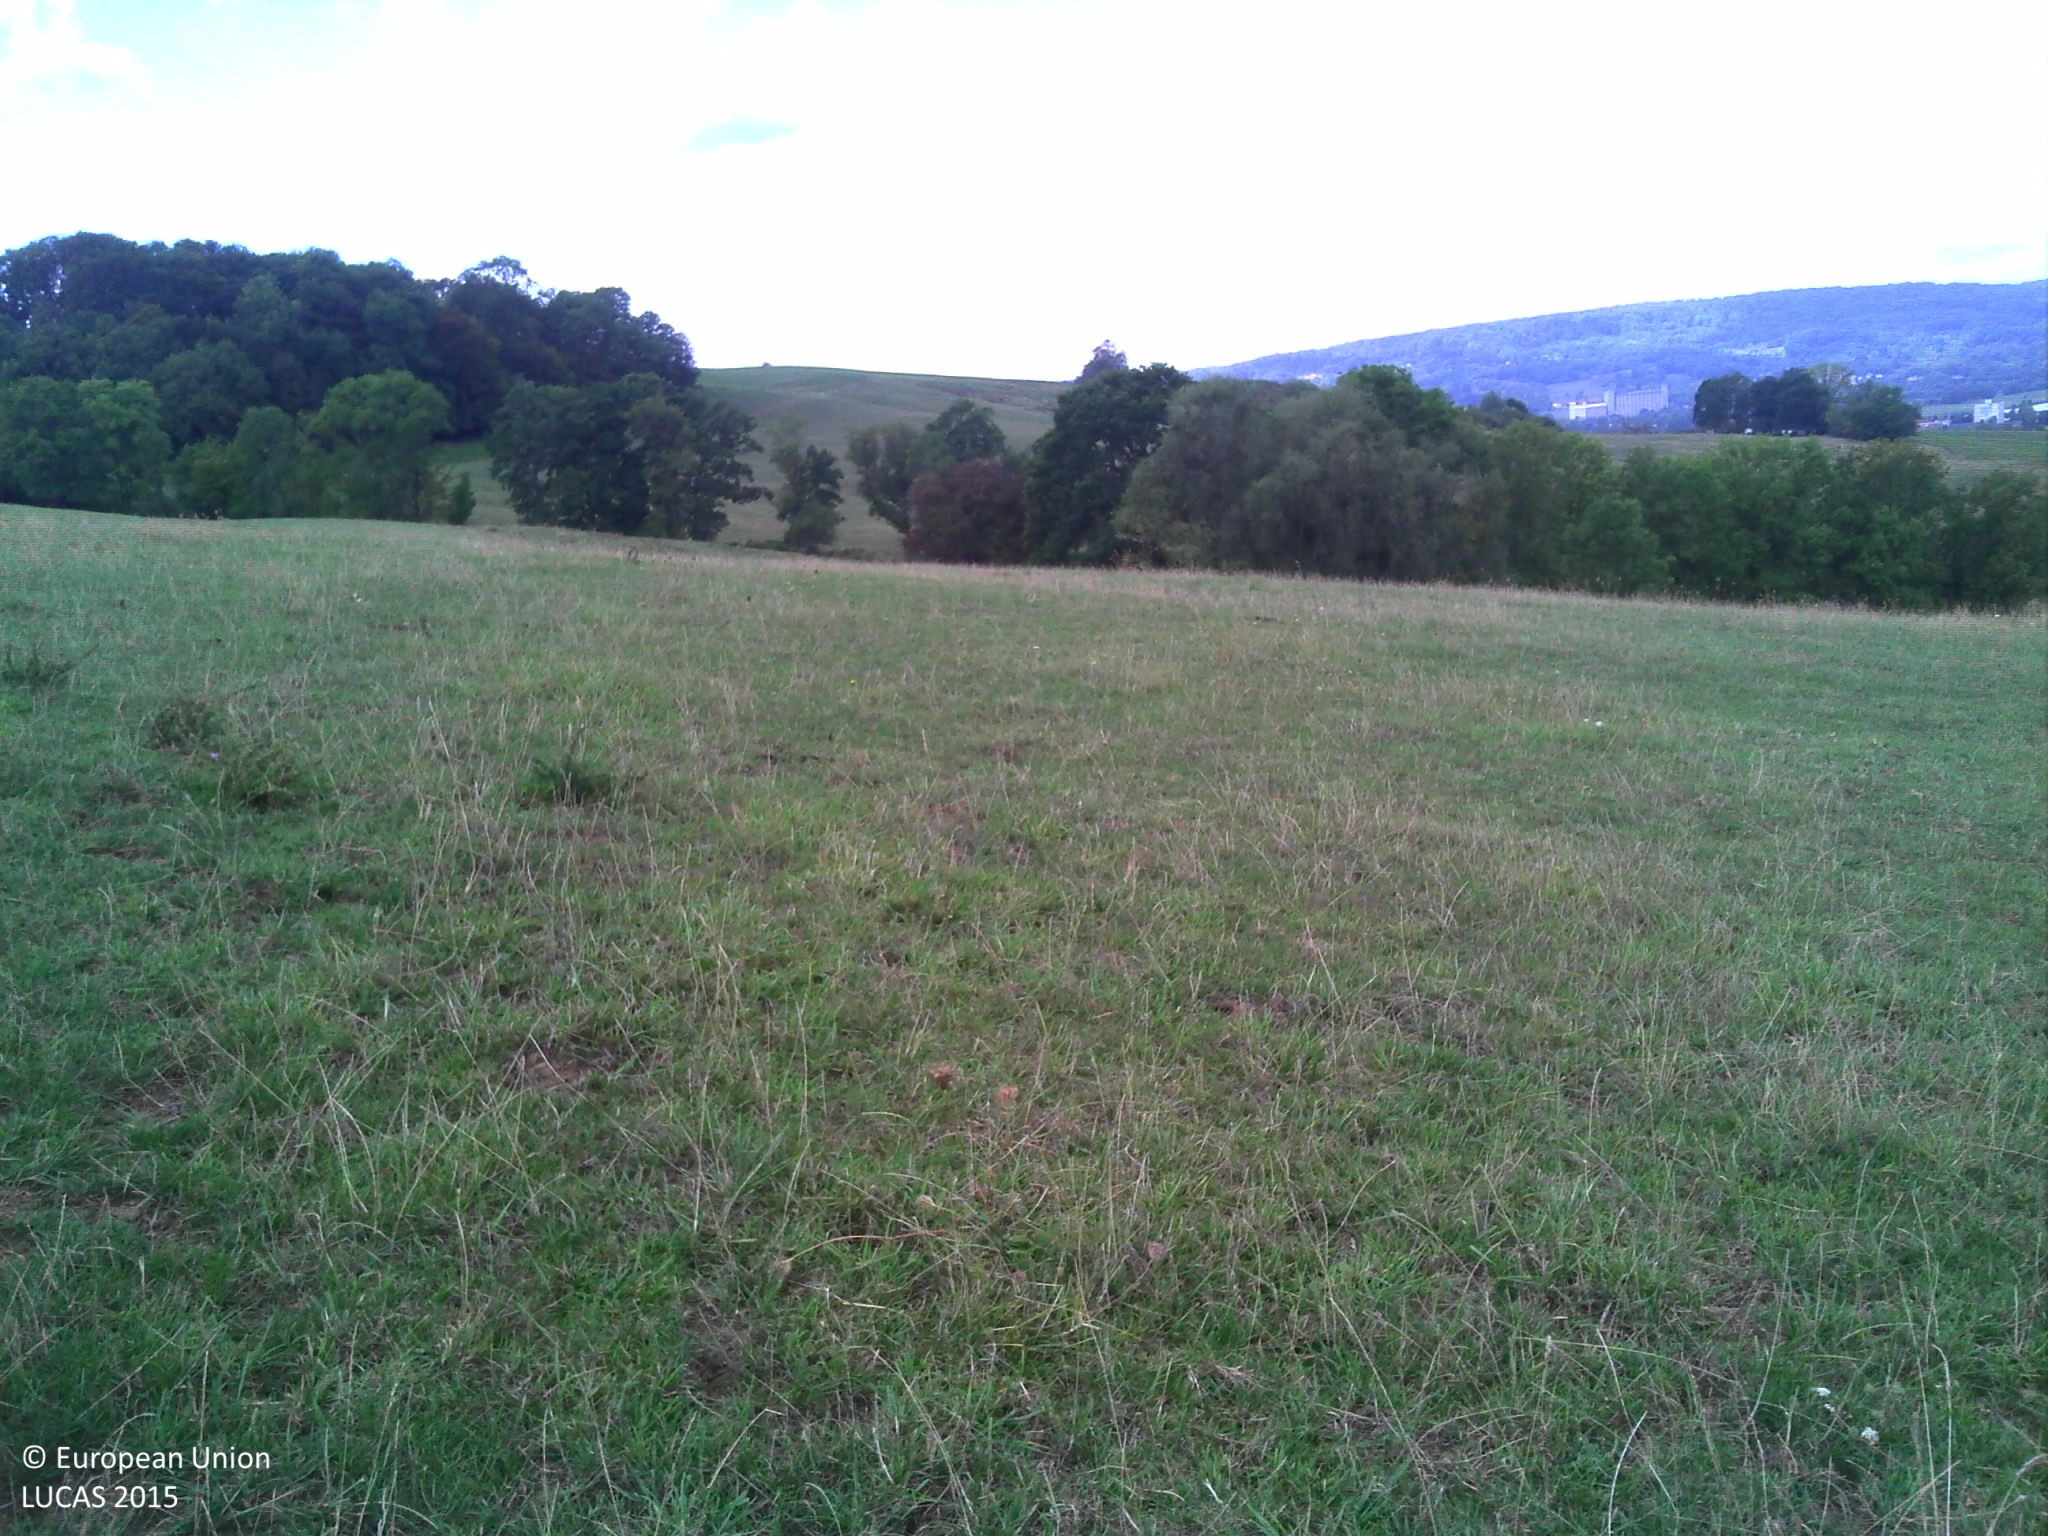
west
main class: Grassland
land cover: Grassland without tree/shrub cover
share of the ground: > 75 %
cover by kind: herbaceous plants 95 %, unconsolidated bare surface 5 %
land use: Agriculture (excluding fallow land and kitchen gardens)
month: September
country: FR
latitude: 48.9106
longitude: 6.0838
